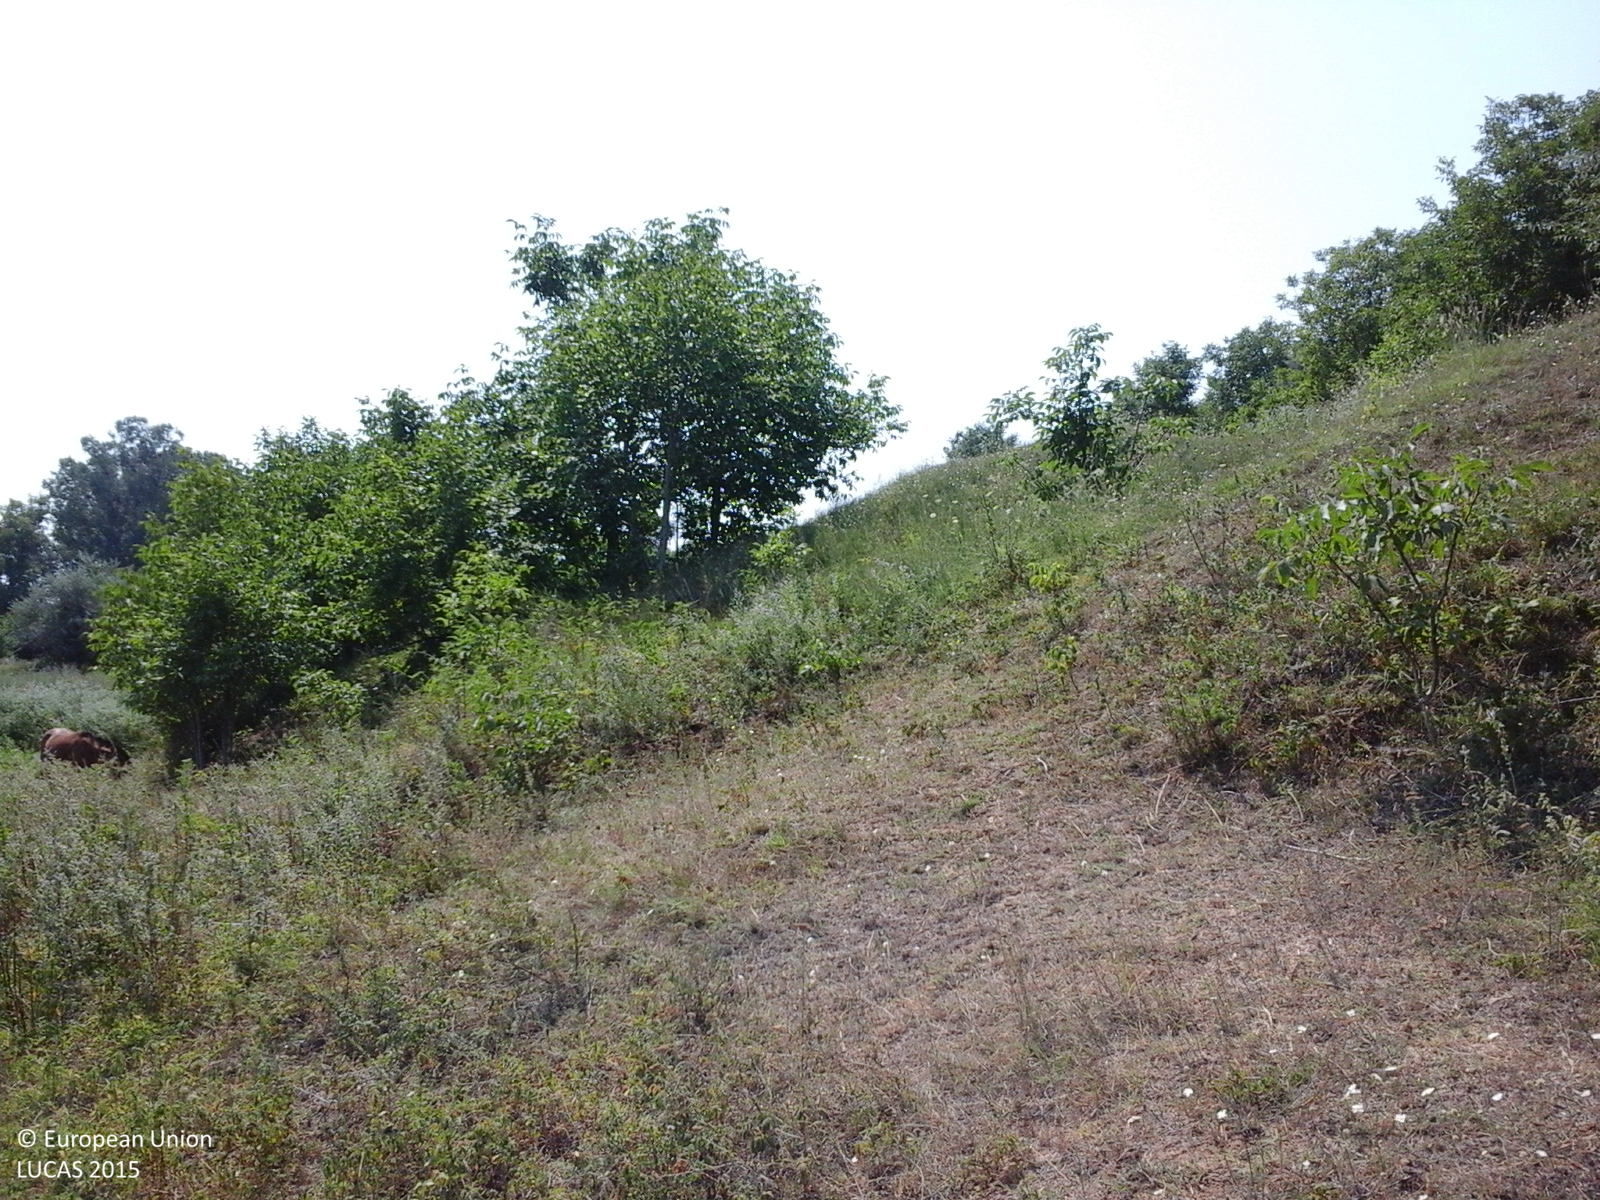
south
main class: Grassland
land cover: Grassland without tree/shrub cover
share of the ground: > 75 %
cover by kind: herbaceous plants 100 %
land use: Agriculture (excluding fallow land and kitchen gardens)
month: July
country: RO
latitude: 45.8350
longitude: 27.9234
